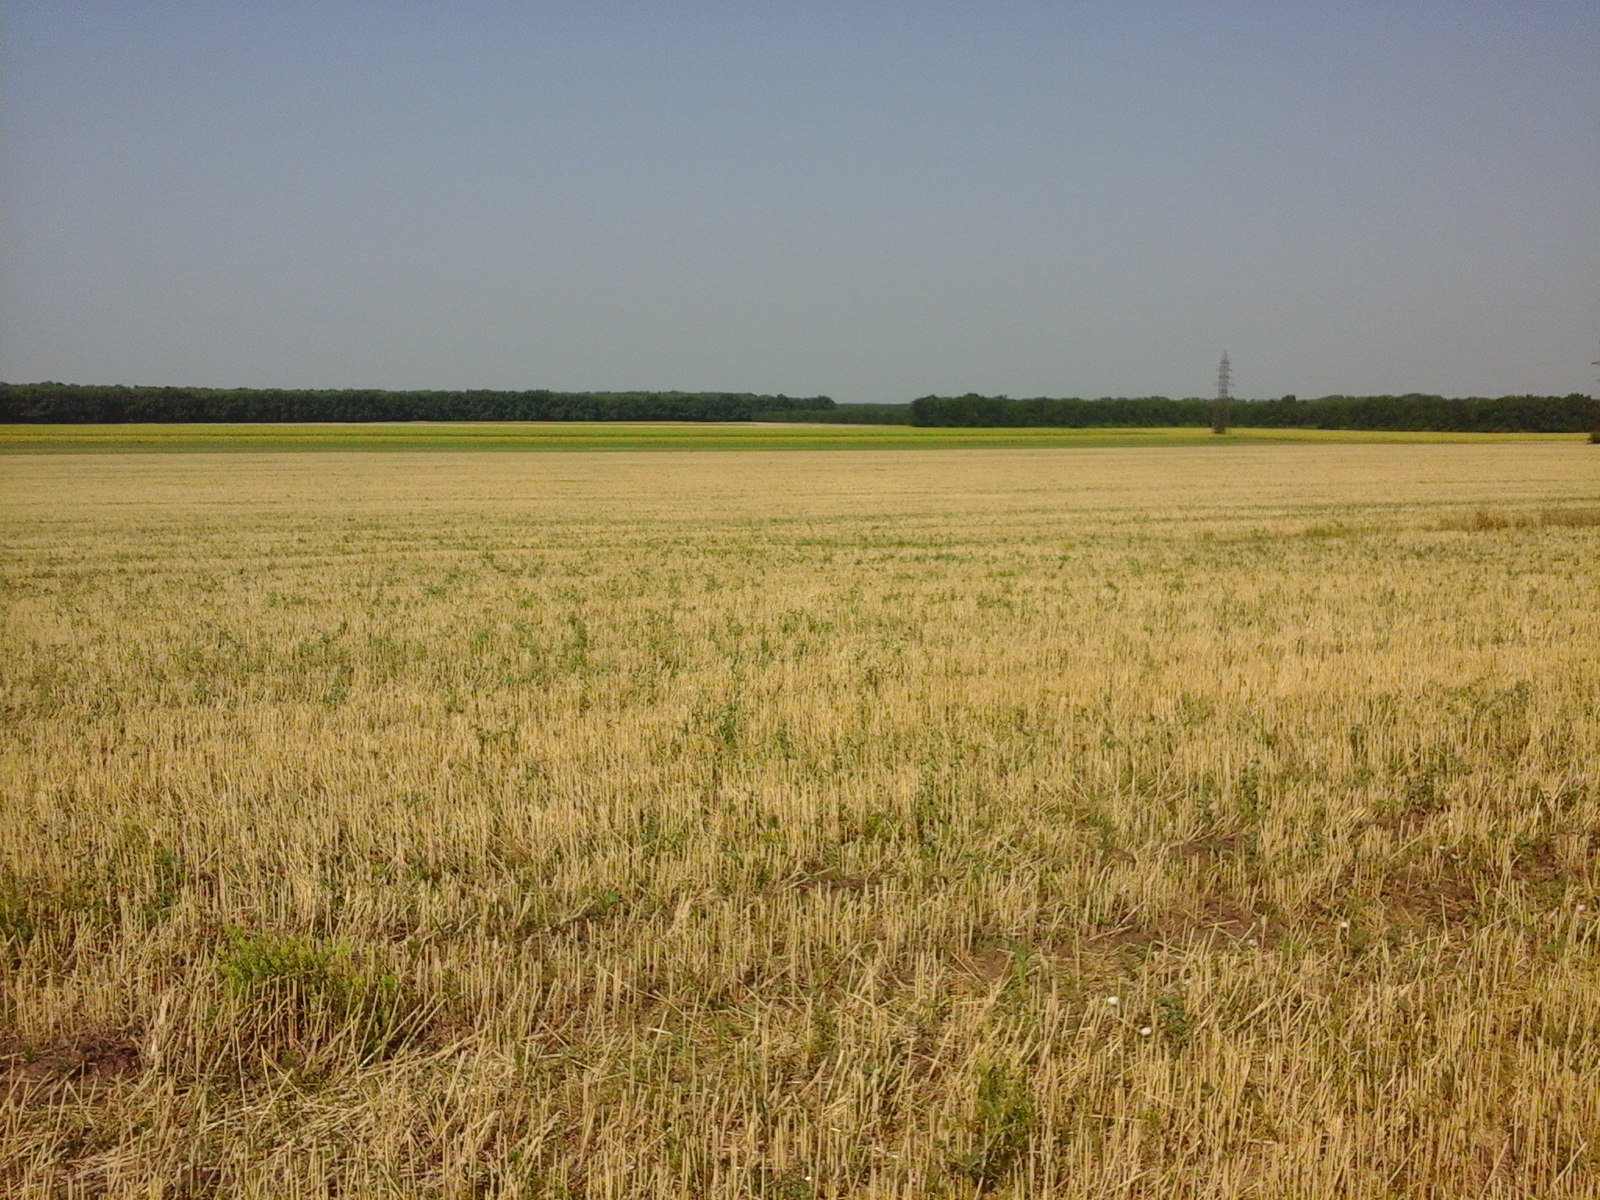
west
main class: Cropland
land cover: Common wheat
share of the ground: > 75 %
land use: Agriculture (excluding fallow land and kitchen gardens)
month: August
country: RO
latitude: 45.8076
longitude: 27.5423
